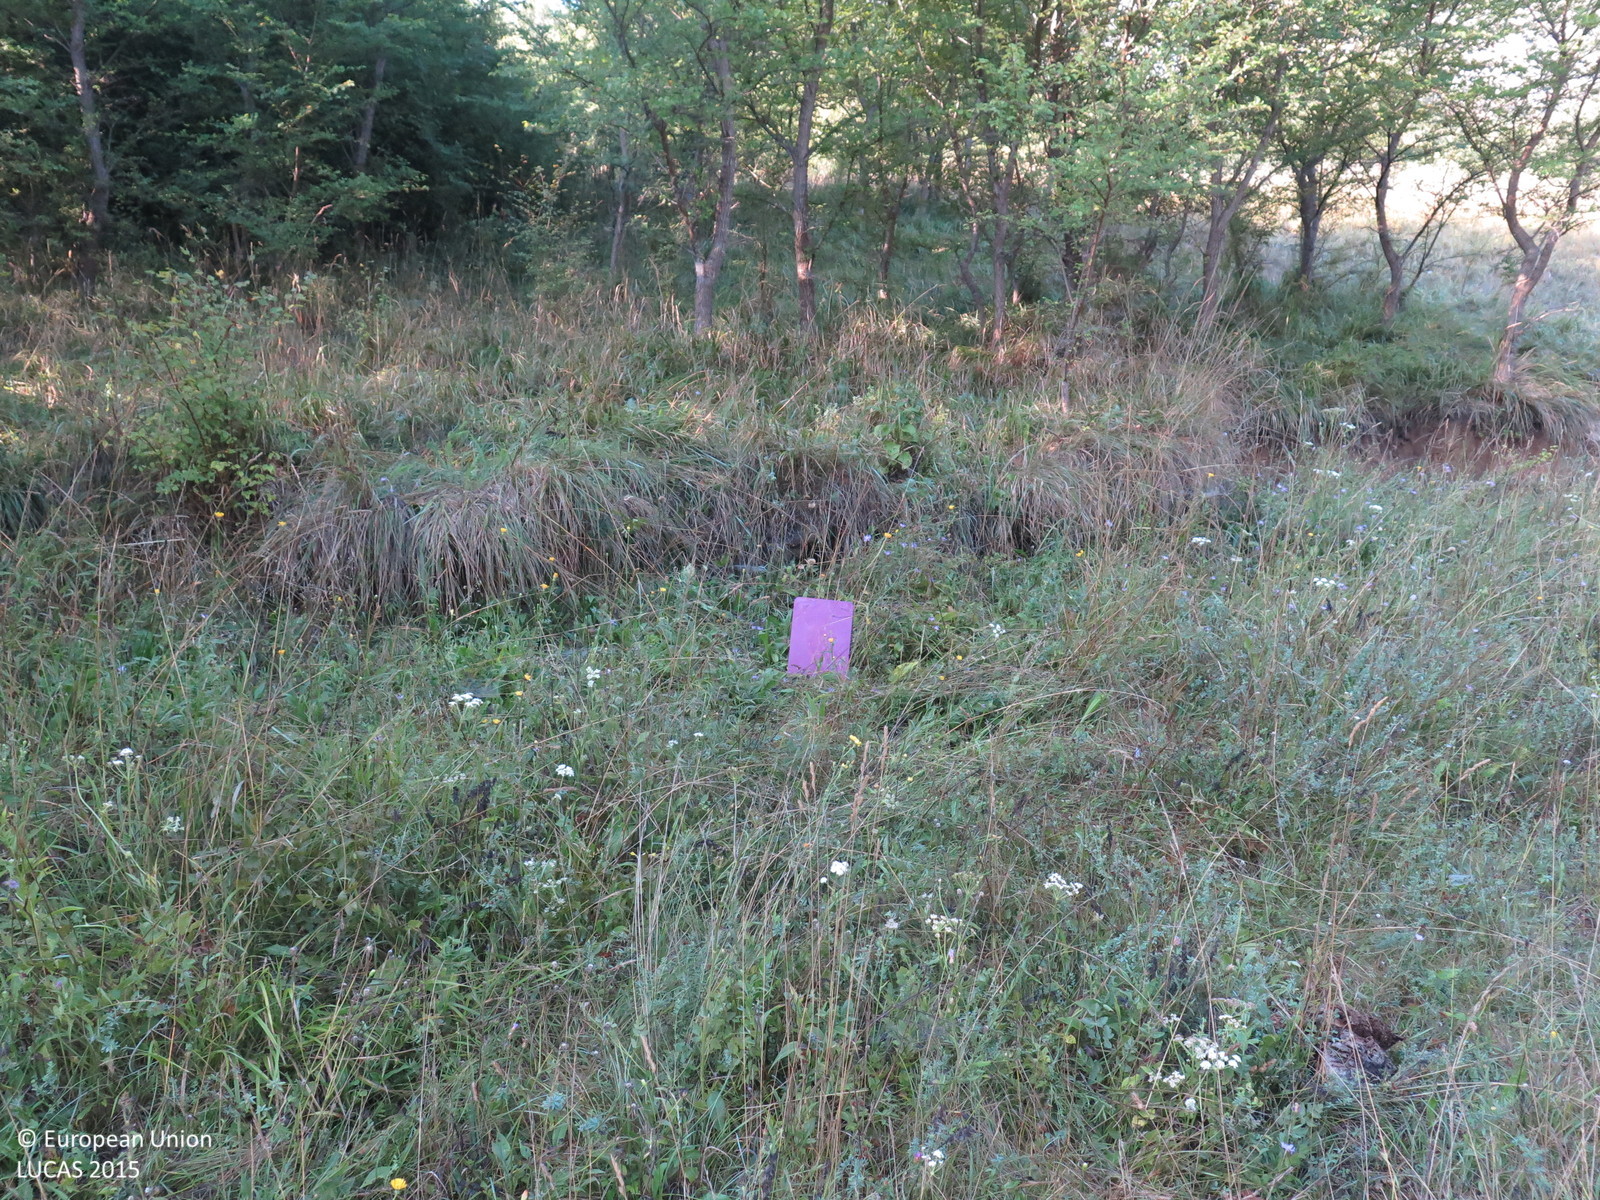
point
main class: Grassland
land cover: Grassland with sparse tree/shrub cover
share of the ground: > 75 %
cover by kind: herbaceous plants 85 %, shrubs 10 %, broadleaved forest trees 5 %
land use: Protection infrastructures
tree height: < 5 m
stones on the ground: 10 - 25 %
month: August
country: HR
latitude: 45.2207
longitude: 14.6685
